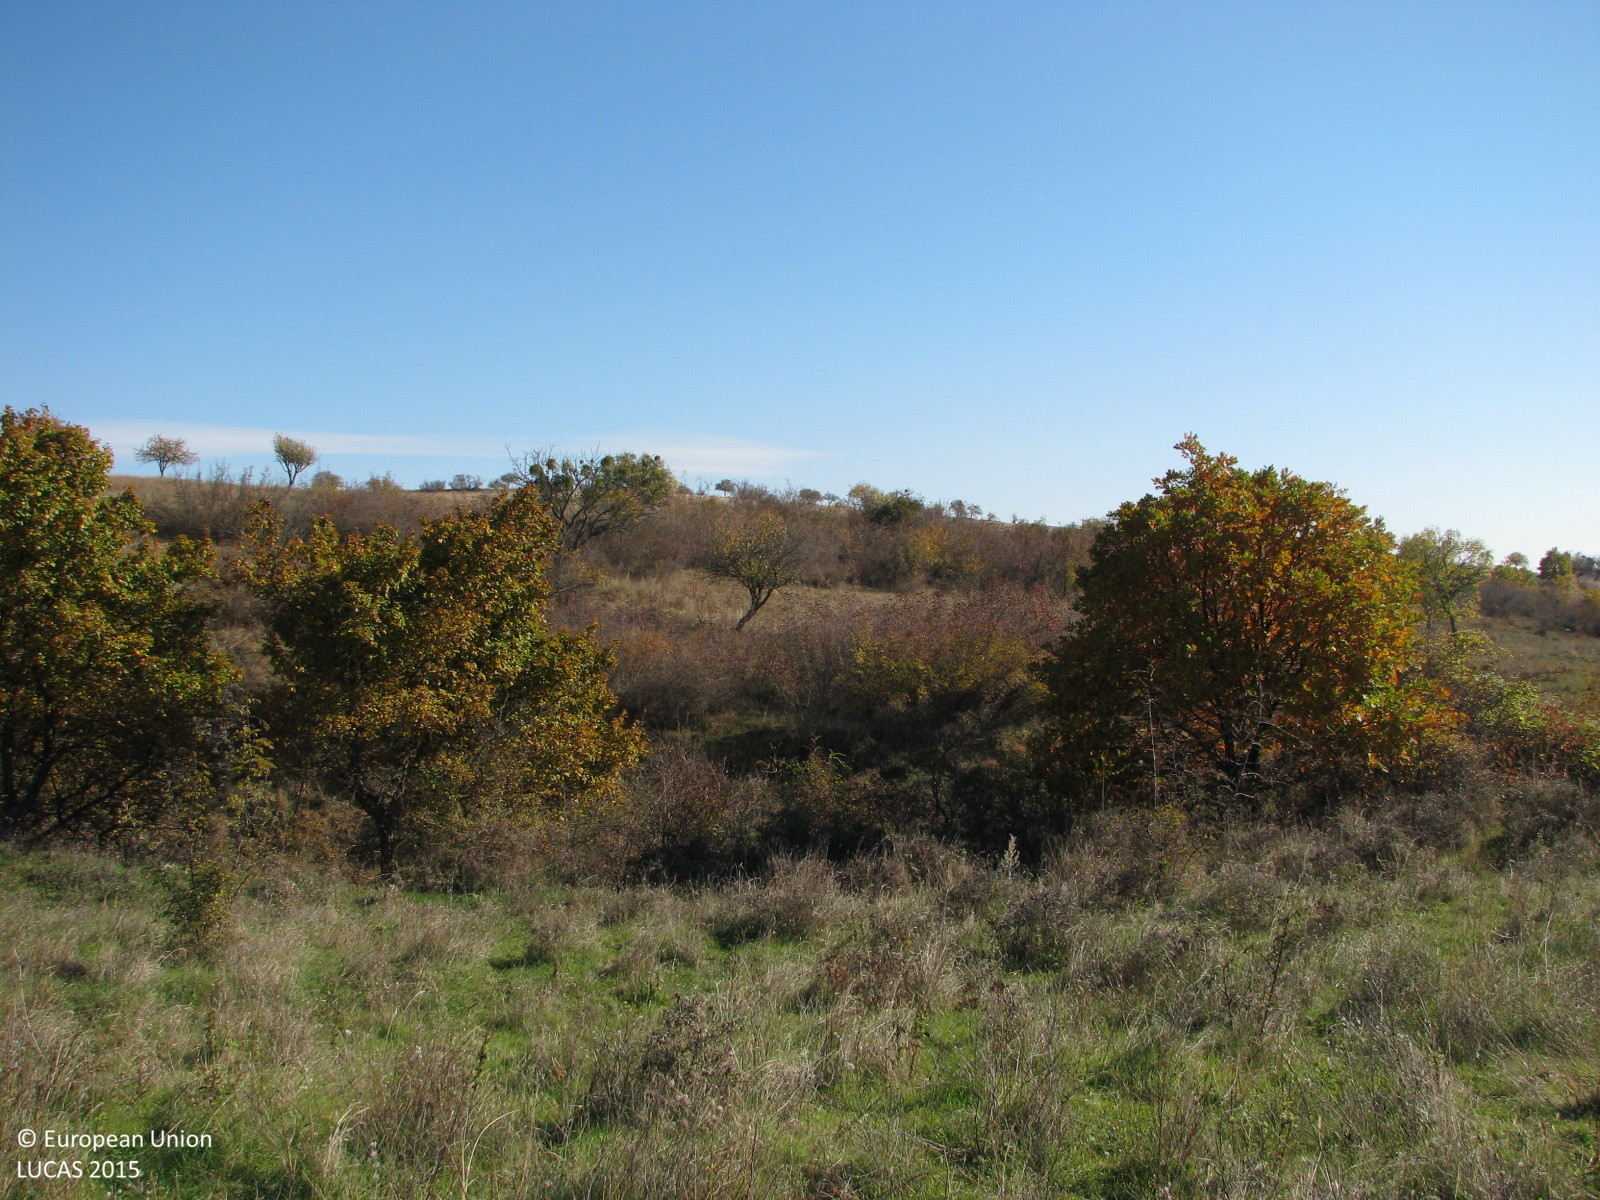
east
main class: Grassland
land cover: Grassland with sparse tree/shrub cover
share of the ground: > 75 %
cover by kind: herbaceous plants 90 %, broadleaved forest trees 5 %, shrubs 5 %
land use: Agriculture (excluding fallow land and kitchen gardens)
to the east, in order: Grassland with sparse tree/shrub cover; Tracks; Inland fresh running water; Shrubland without tree cover; Fences; Grassland without tree/shrub cover; Fences; Shrubland without tree cover; Grassland without tree/shrub cover; Tracks; Grassland without tree/shrub cover; Shrubland without tree cover; Broadleaved woodland; Ditches and canals; Broadleaved woodland; Grassland with sparse tree/shrub cover
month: November
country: BG
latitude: 41.8968
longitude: 26.3899
